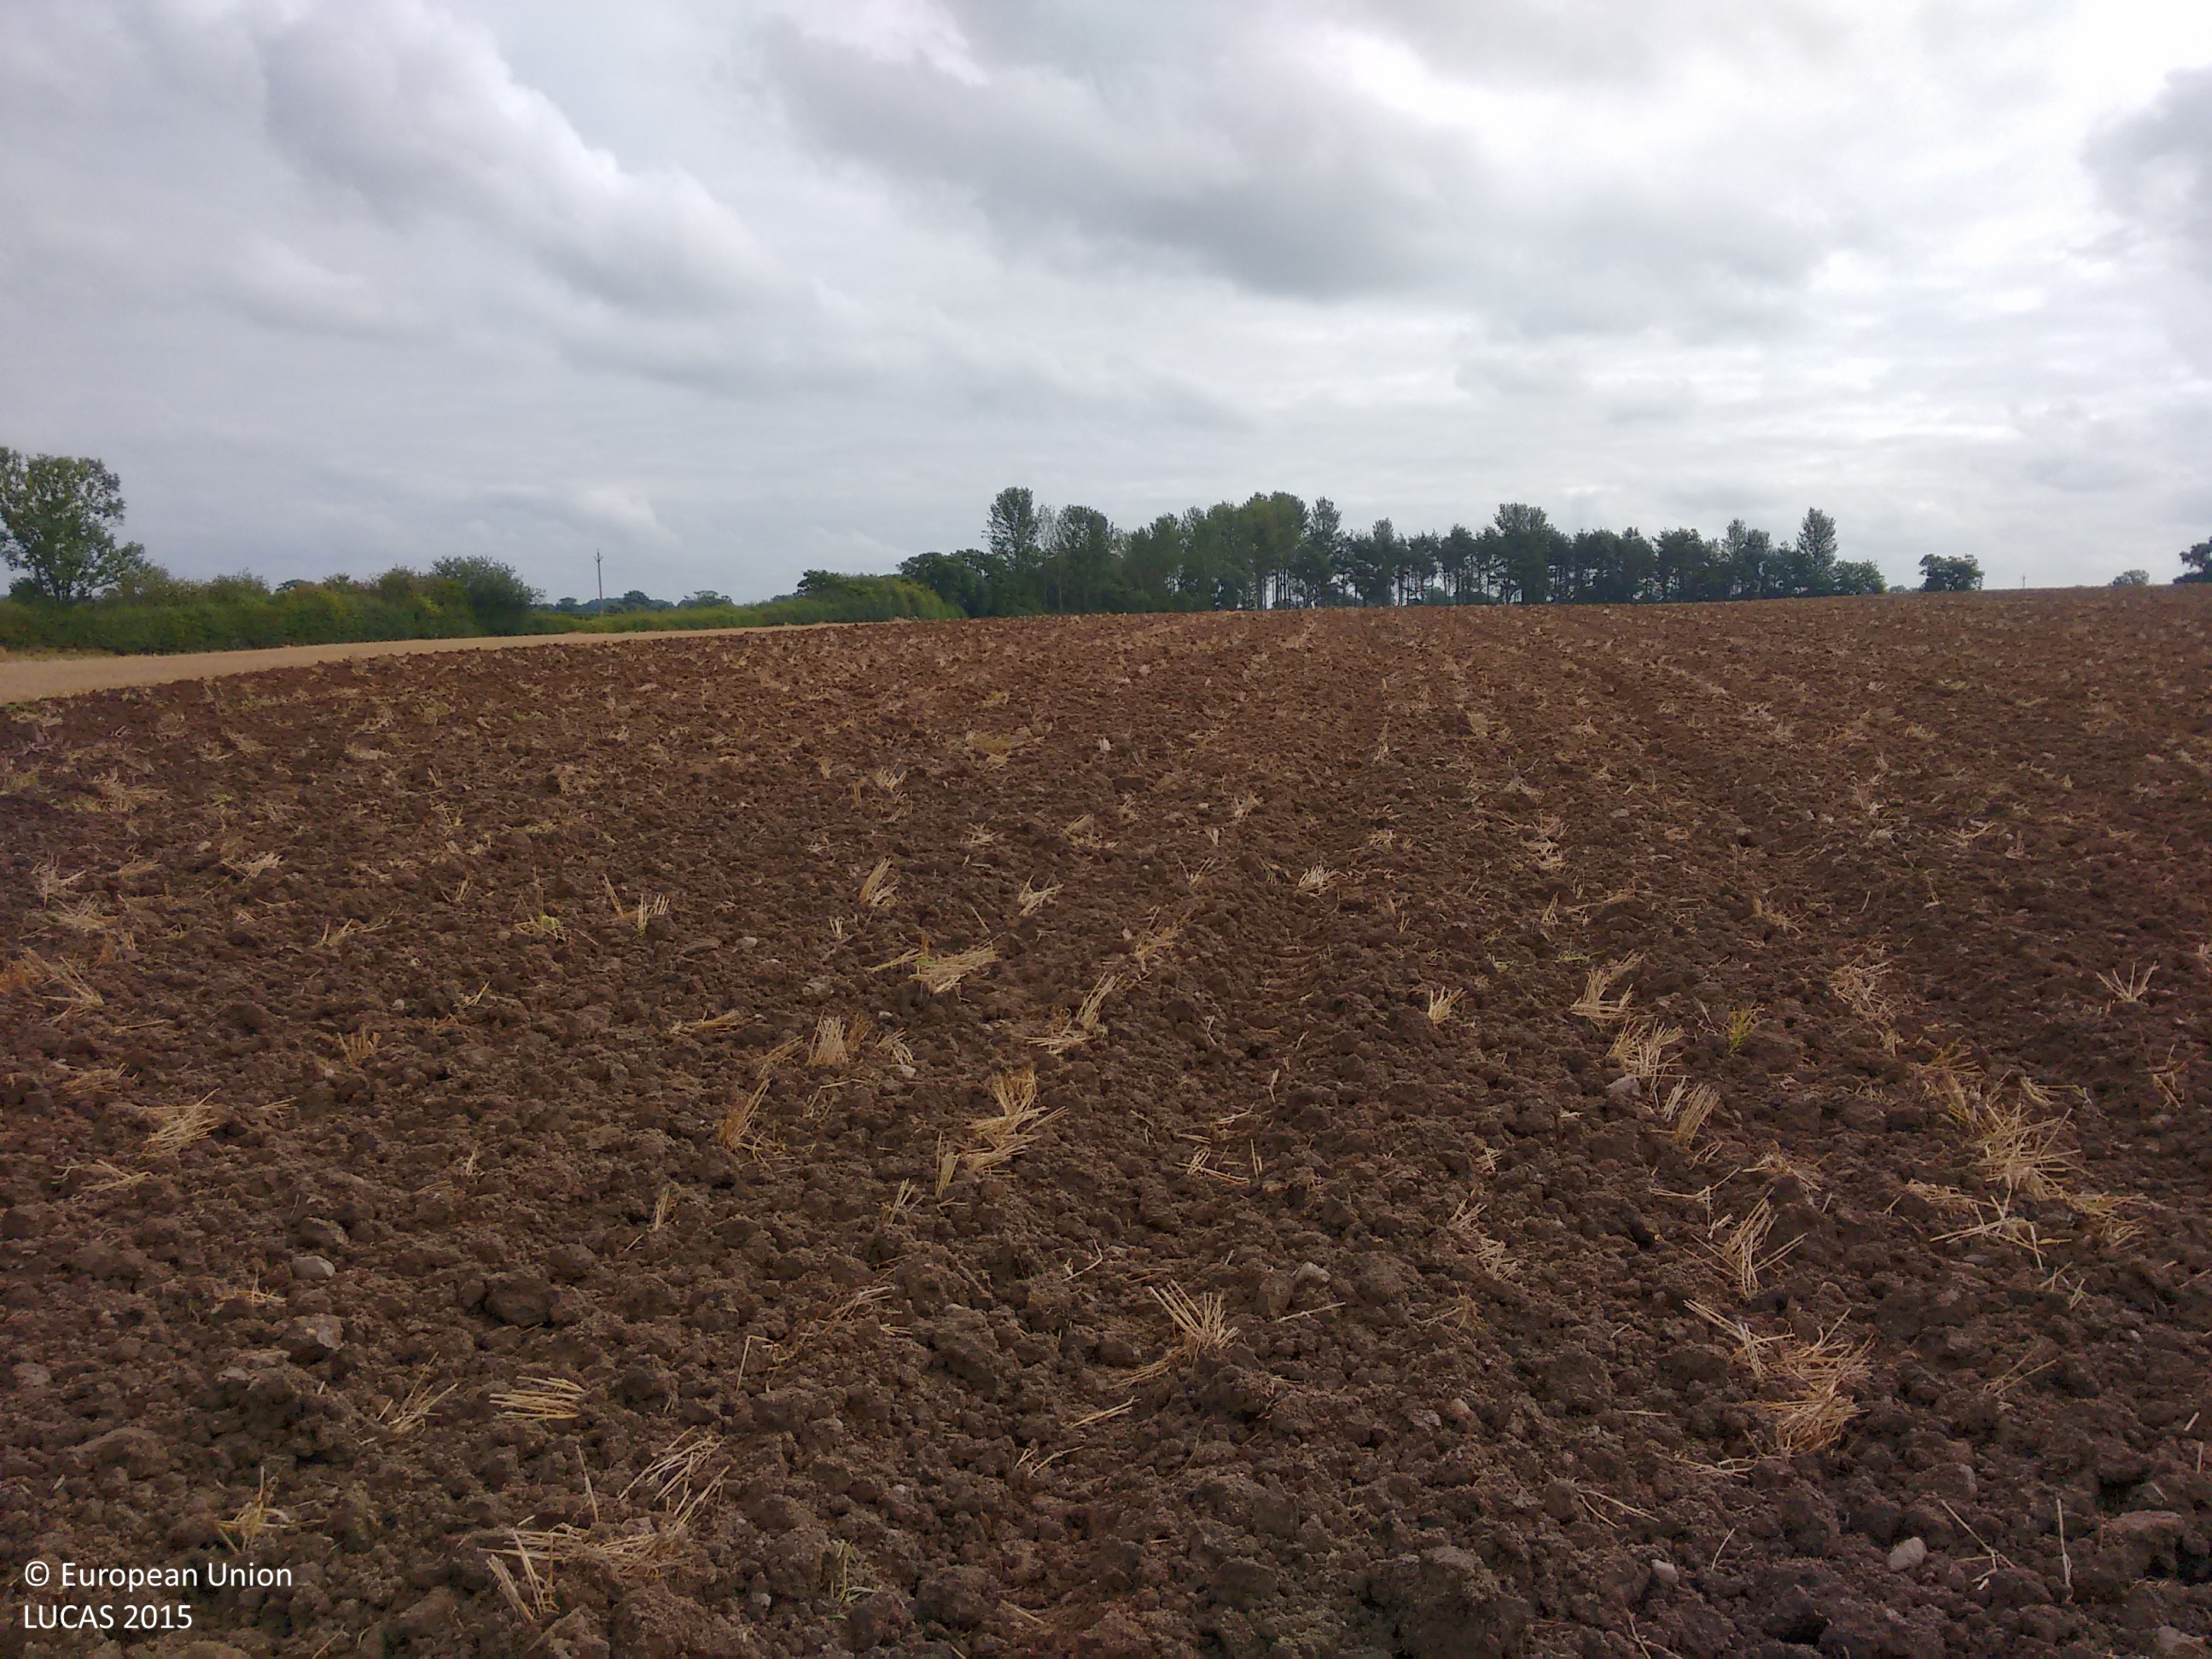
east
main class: Cropland
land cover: Barley
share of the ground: < 10 %
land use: Agriculture (excluding fallow land and kitchen gardens)
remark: Harvested field
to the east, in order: Barley; Other bare soil
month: September
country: GB
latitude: 52.8600
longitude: -3.0116
